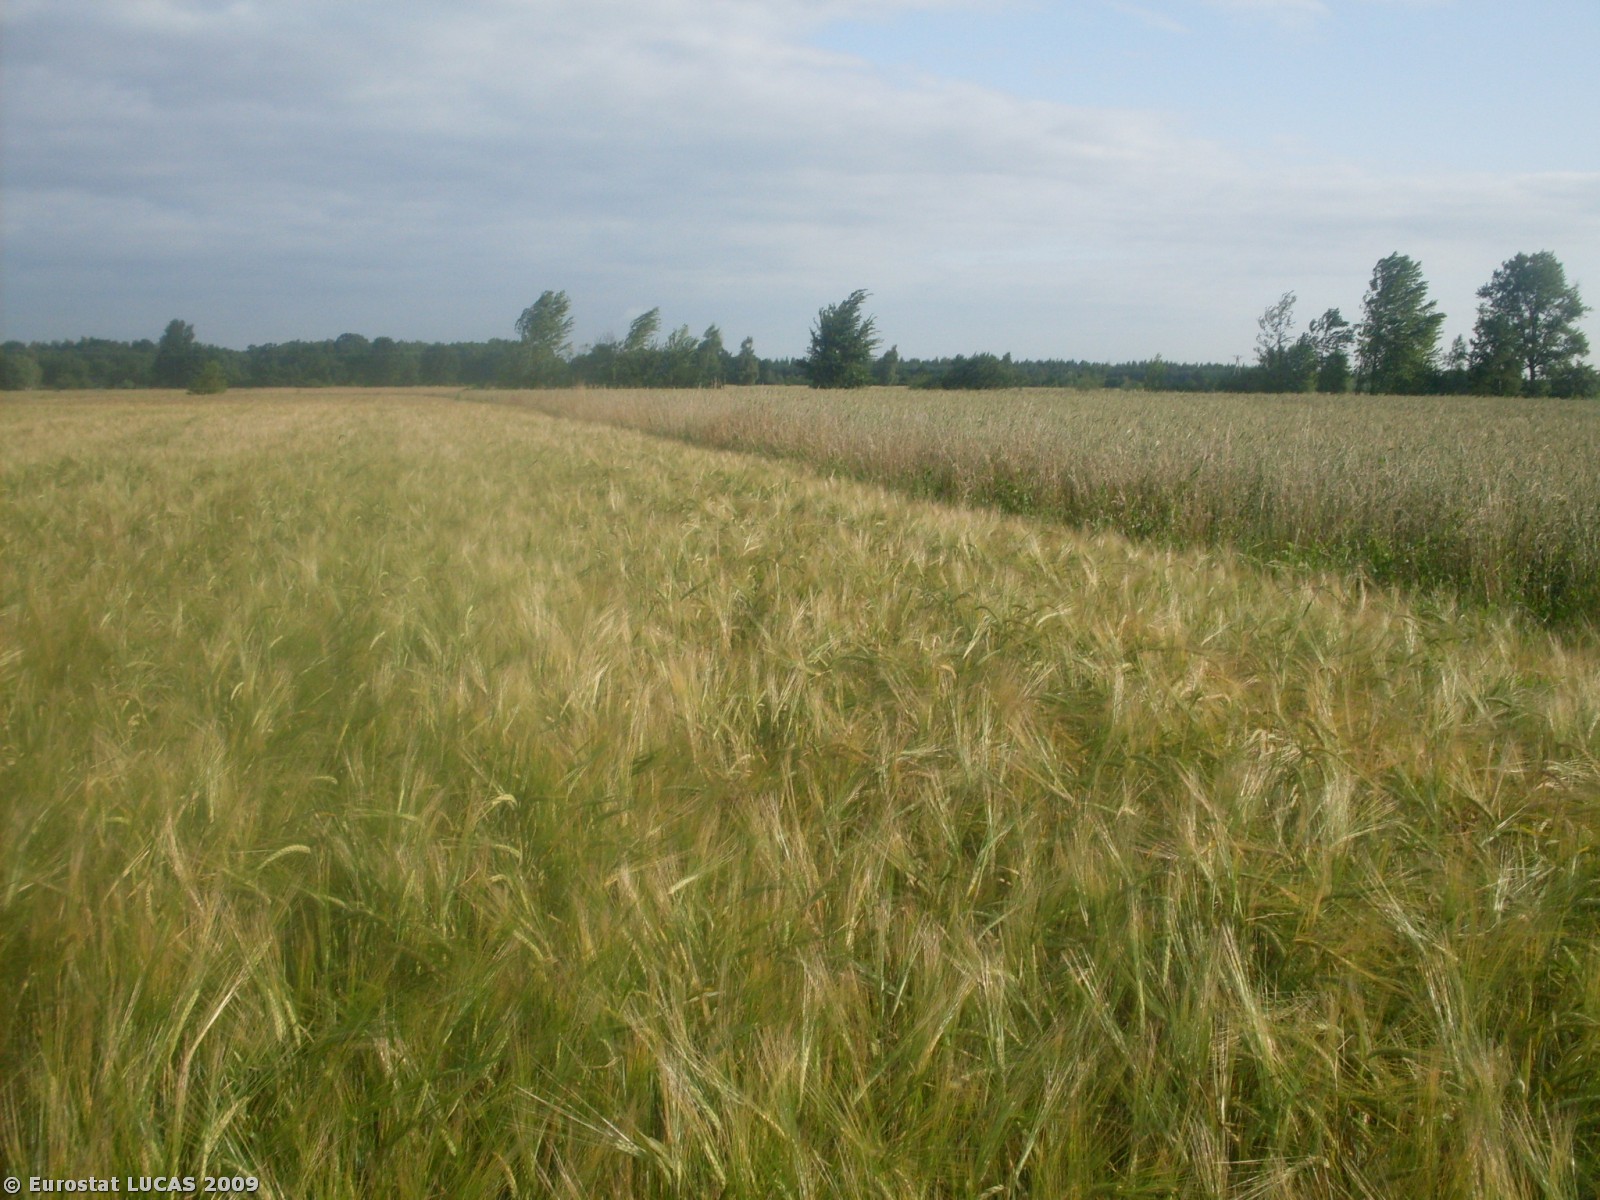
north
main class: Cropland
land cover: Barley
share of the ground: > 75 %
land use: Agriculture (excluding fallow land and kitchen gardens)
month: July
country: PL
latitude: 50.3015
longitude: 21.2079
